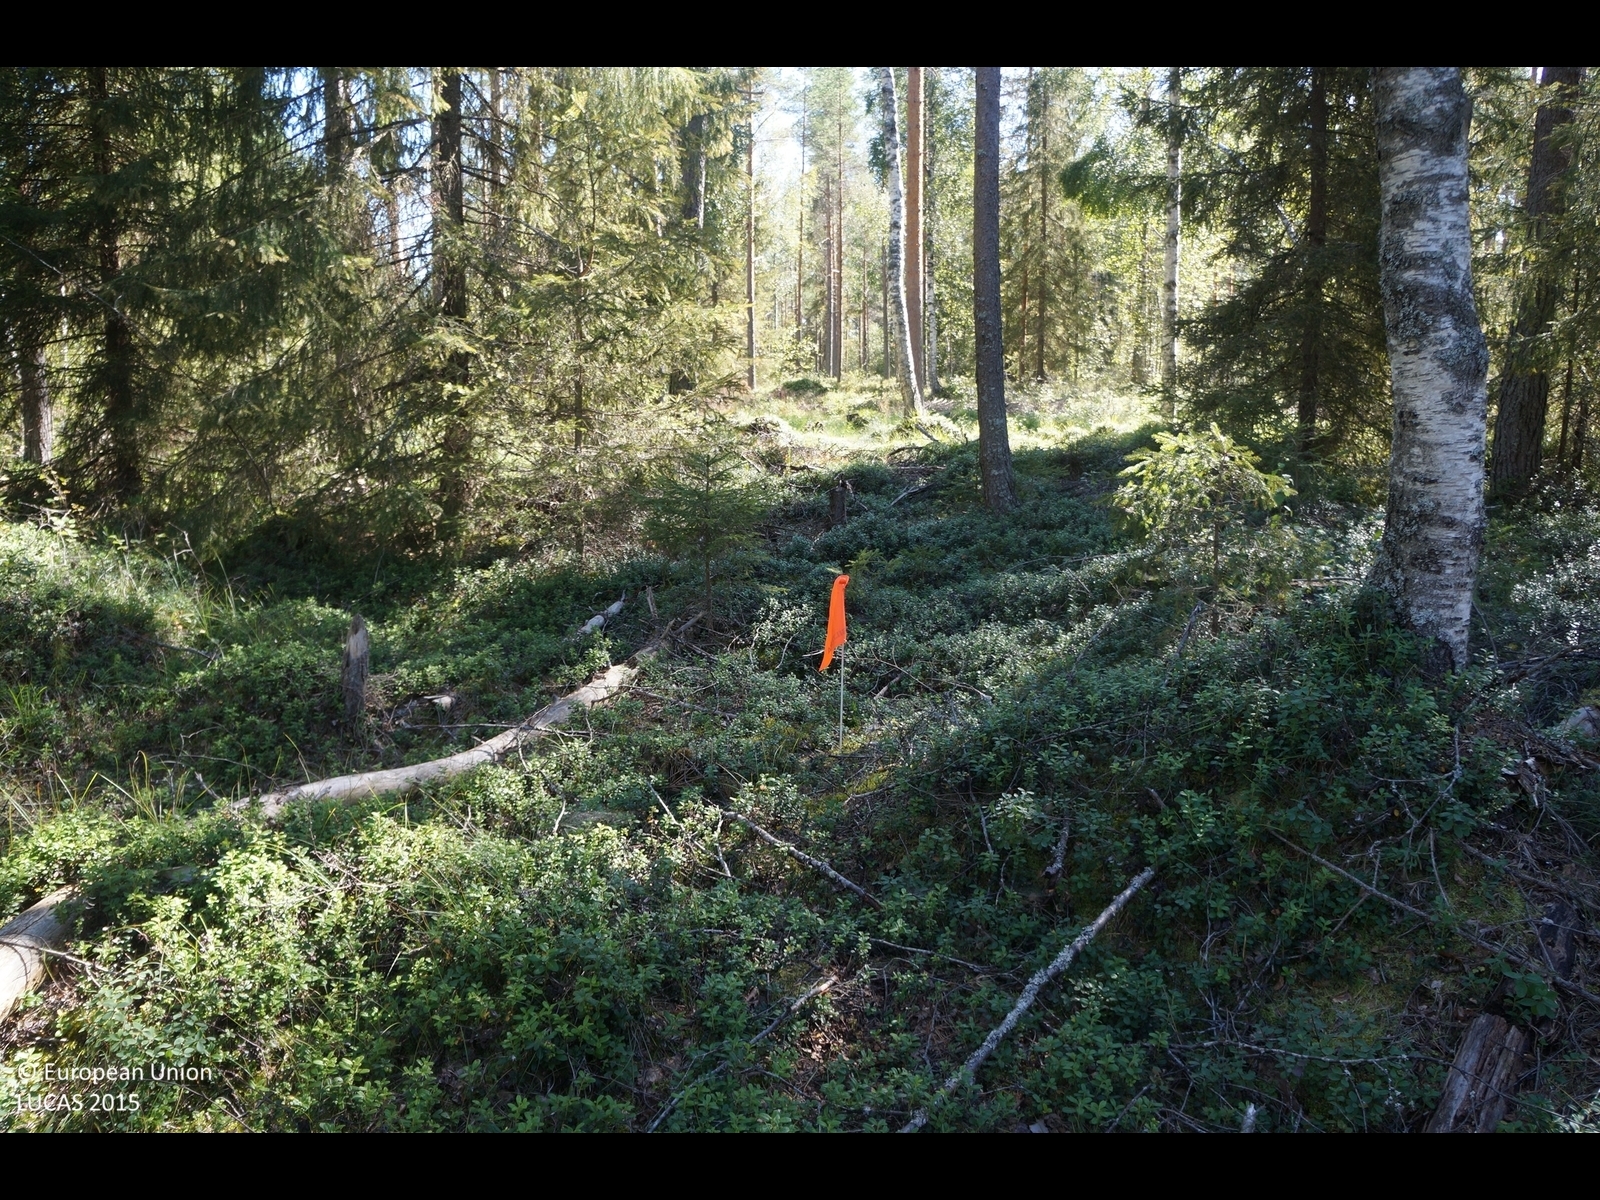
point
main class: Woodland
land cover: Other mixed woodland
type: boreal forest
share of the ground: 50 - 75 %
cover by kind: coniferous forest trees 35 %, shrubs 30 %, broadleaved forest trees 20 %, lichens and mosses 10 %, herbaceous plants 5 %
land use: Forestry
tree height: > 5 m
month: August
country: FI
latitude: 63.9393
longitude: 23.7928
